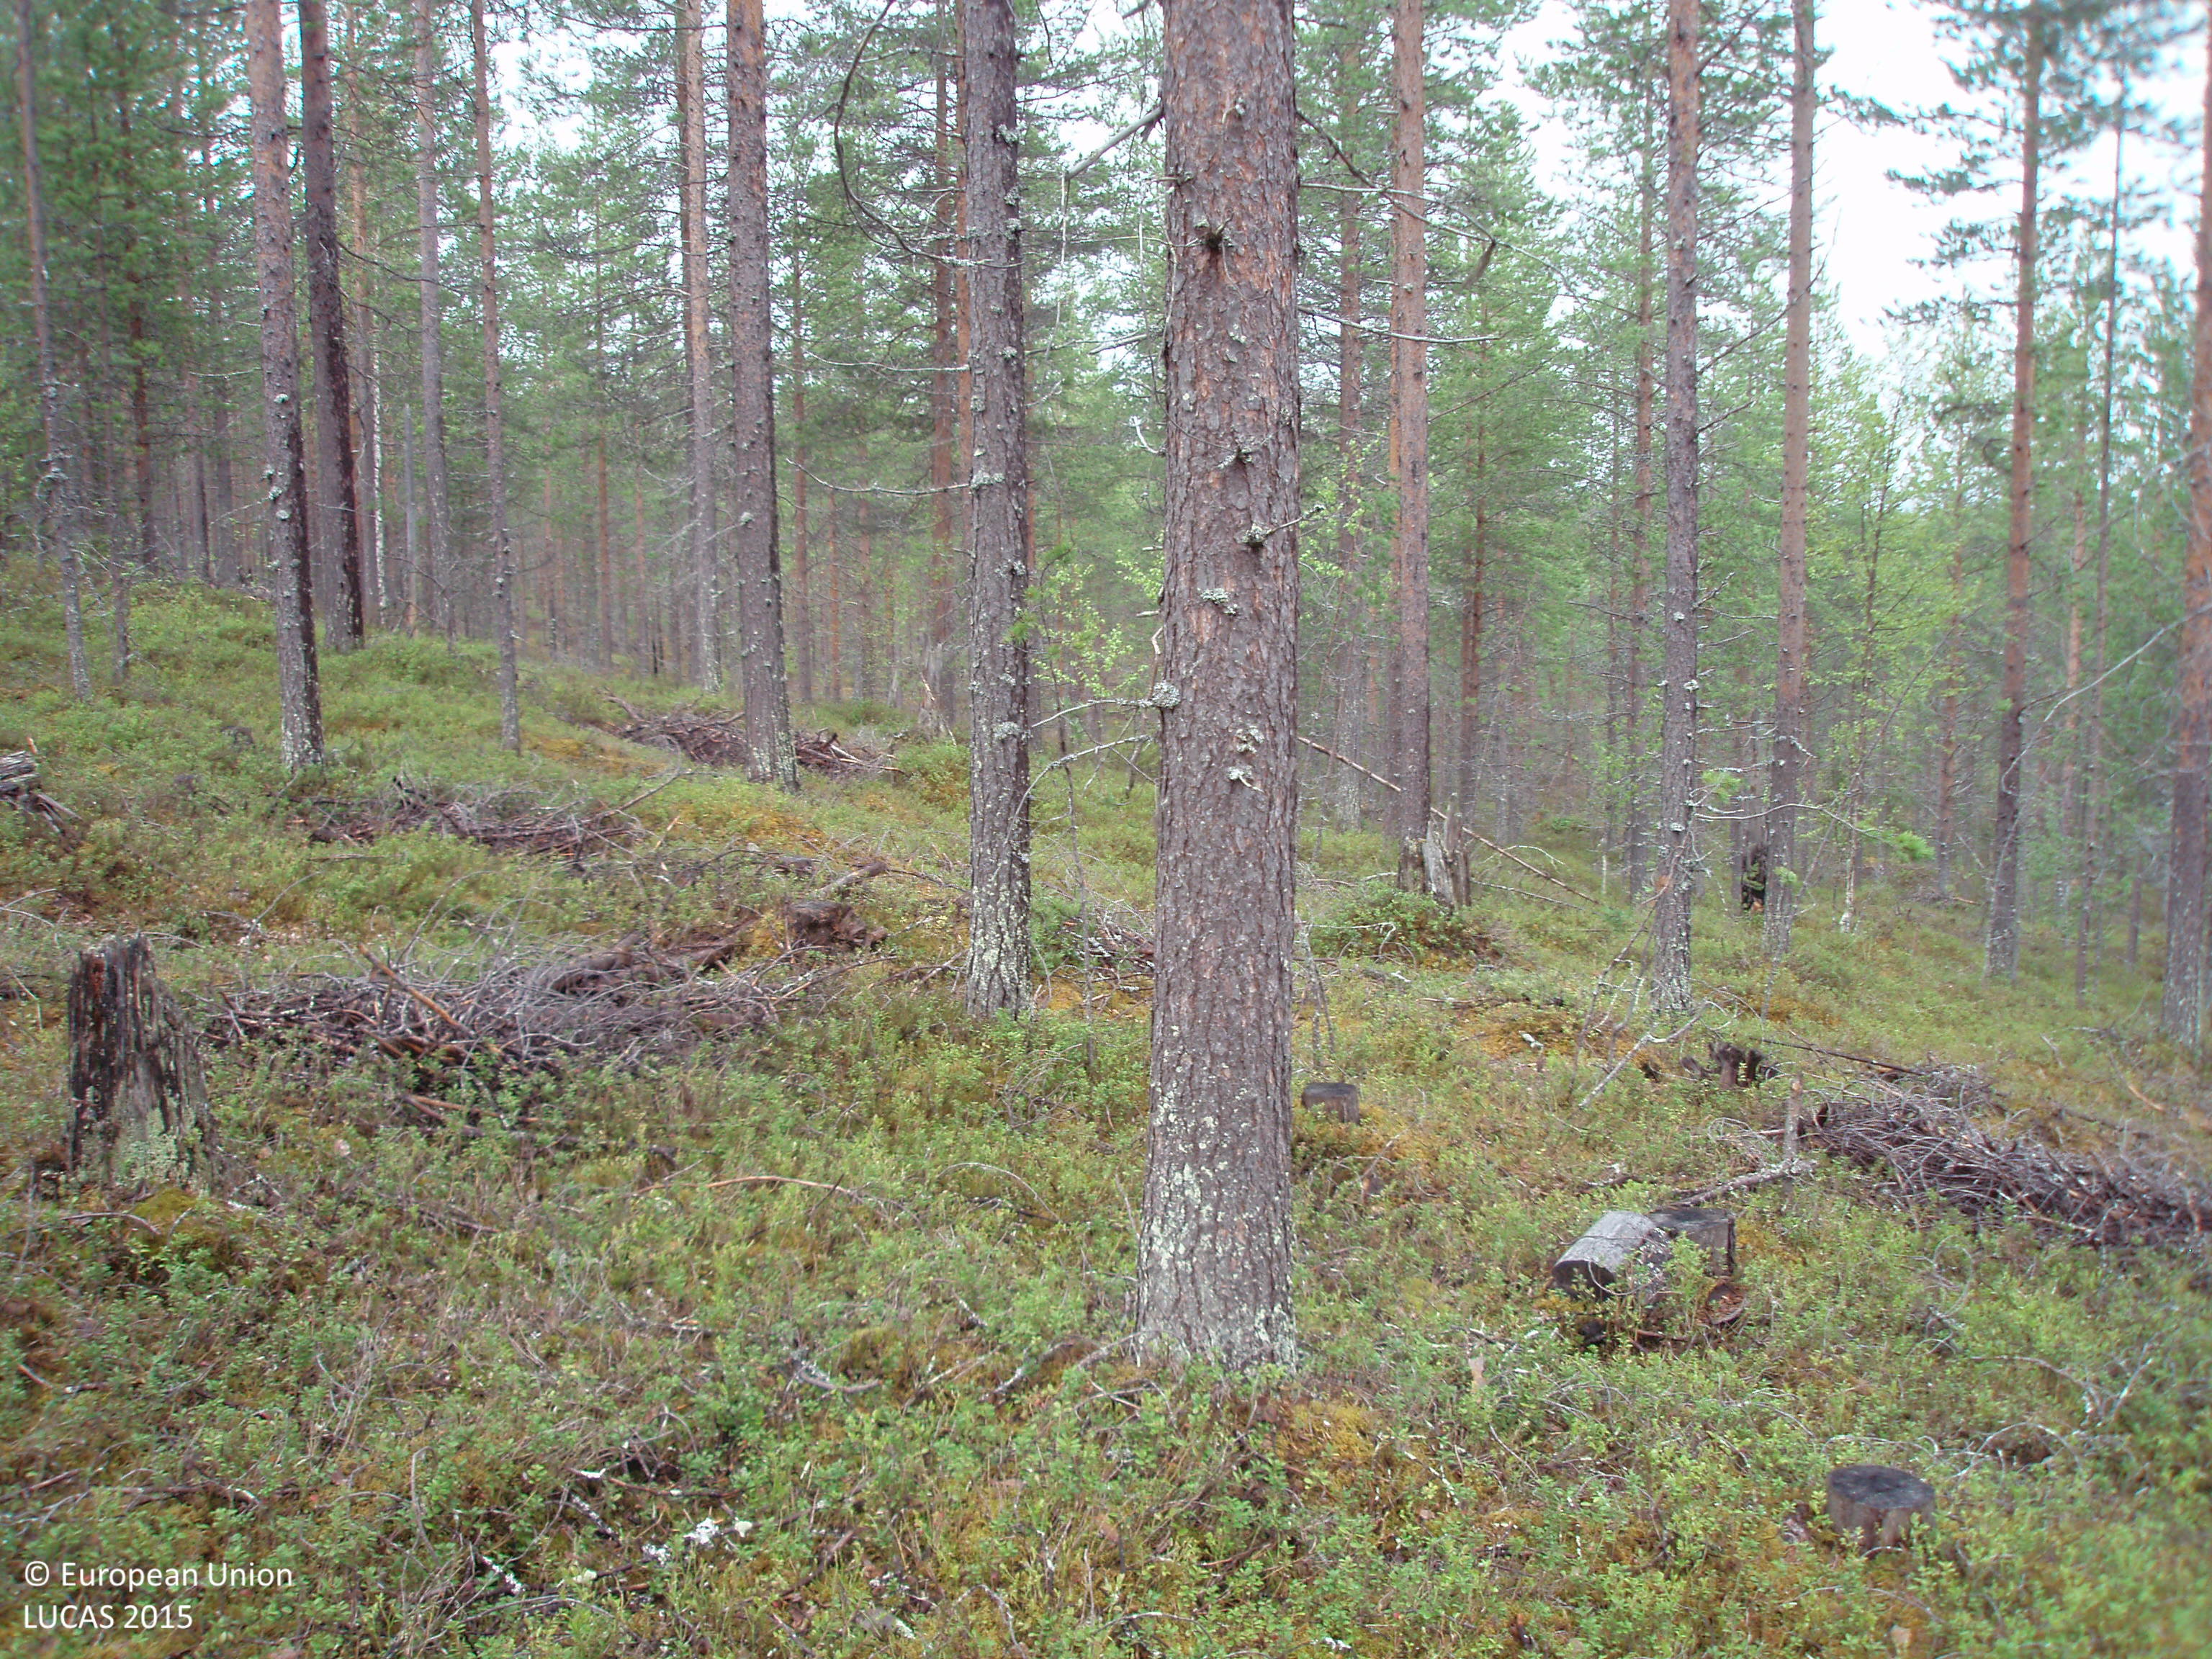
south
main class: Woodland
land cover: Pine dominated coniferous woodland
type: boreal forest
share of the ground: 50 - 75 %
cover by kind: coniferous forest trees 60 %, shrubs 30 %, broadleaved forest trees 10 %
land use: Forestry
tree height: > 5 m
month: June
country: FI
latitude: 66.5696
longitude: 27.2567
